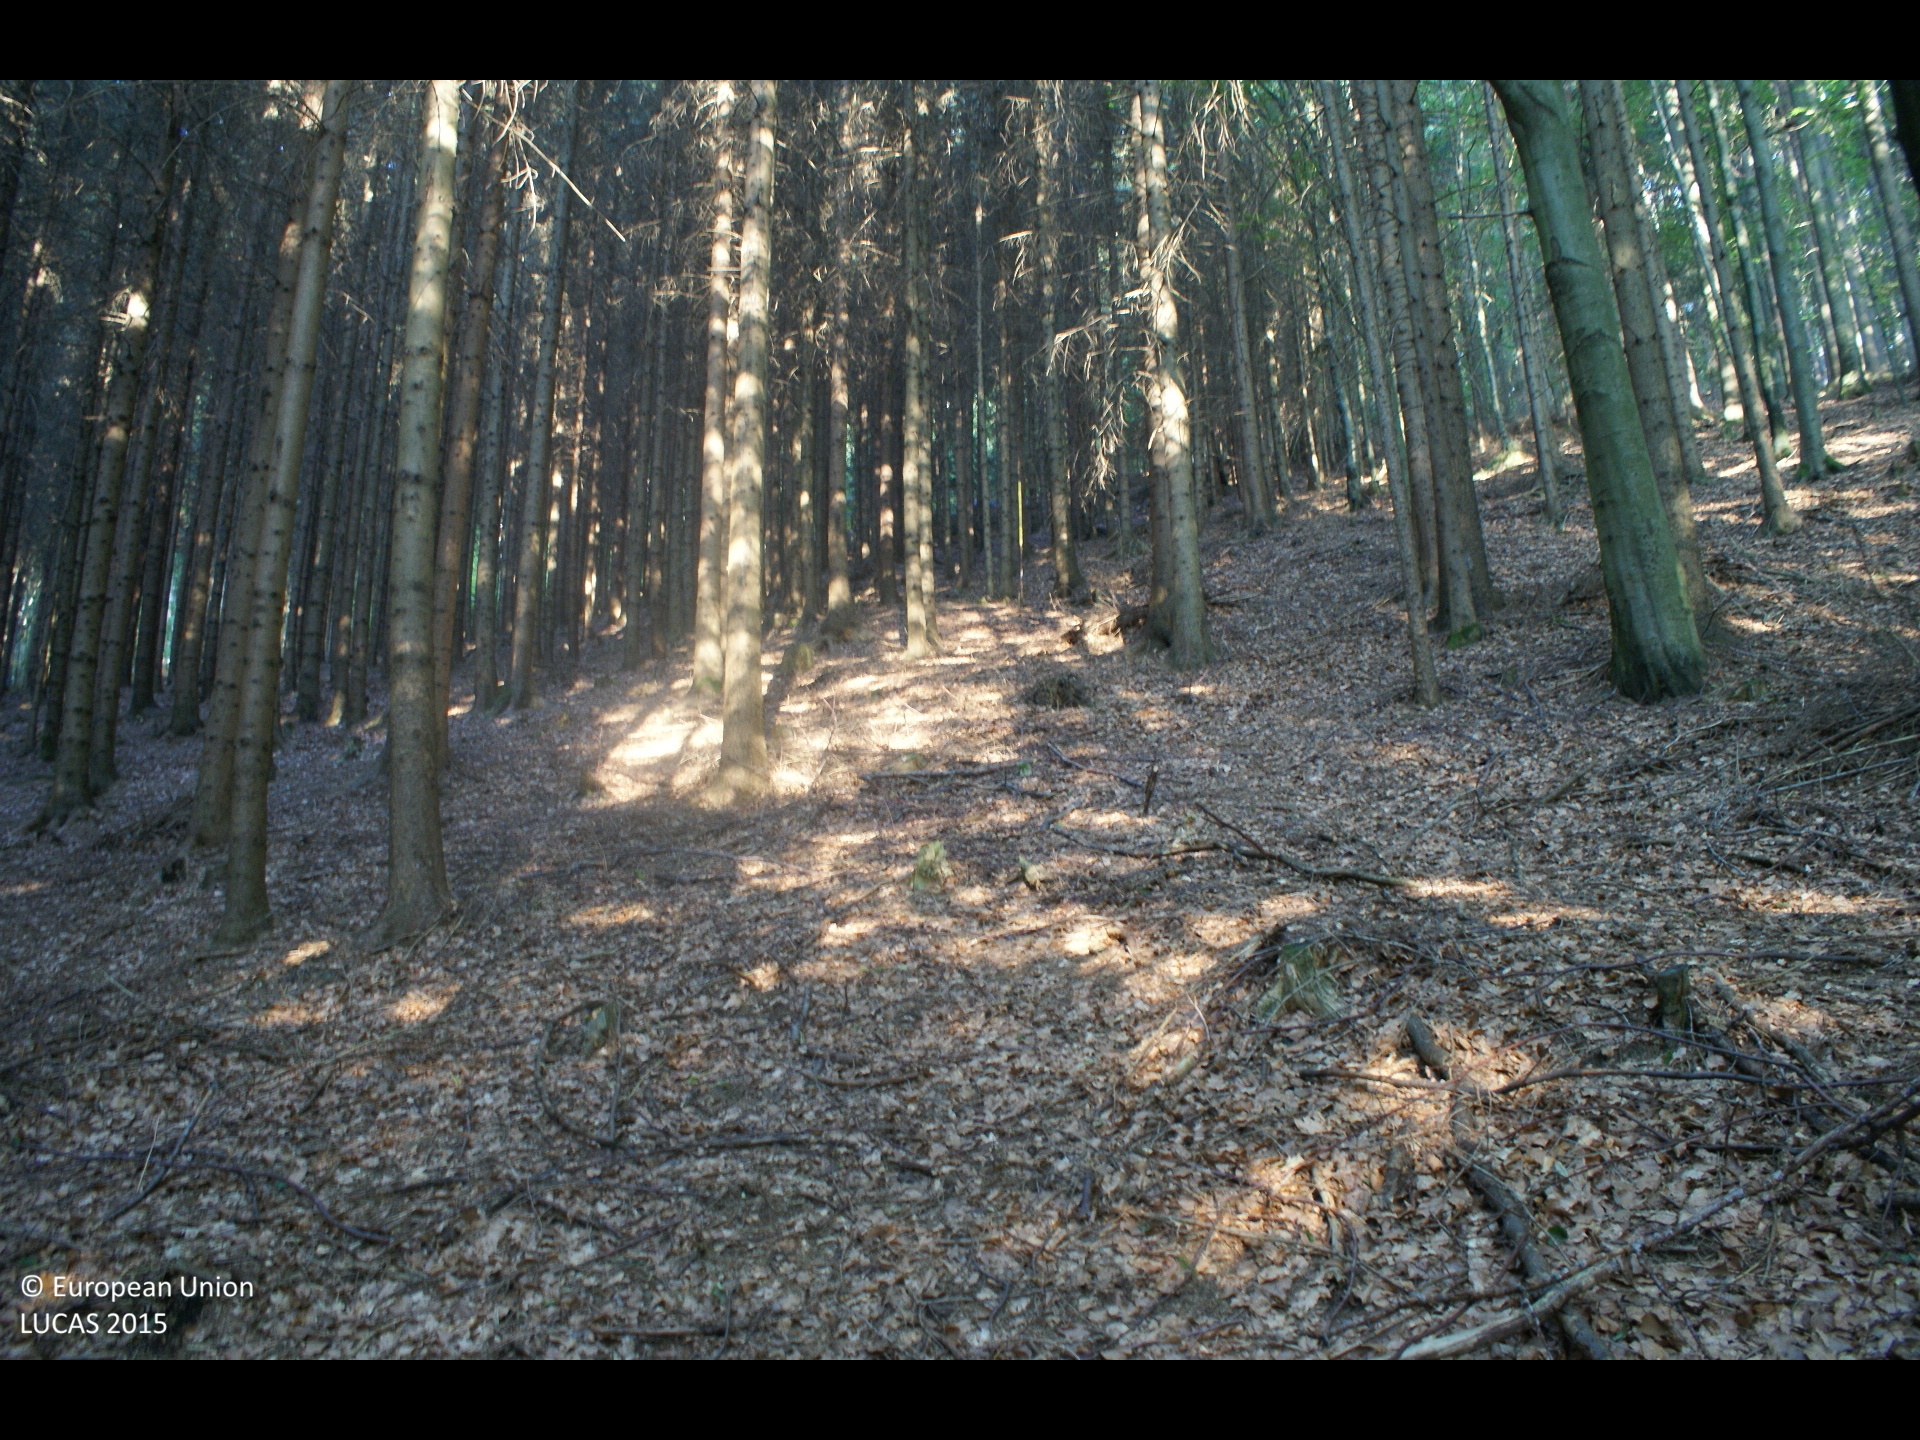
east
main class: Woodland
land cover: Spruce dominated coniferous woodland
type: alpine coniferous forest
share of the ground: > 75 %
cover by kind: coniferous forest trees 100 %
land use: Forestry
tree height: > 5 m
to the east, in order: Spruce dominated coniferous woodland; Other mixed woodland; Tracks; Spruce dominated mixed woodland; Other mixed woodland; Tracks; Other mixed woodland; Spruce dominated mixed woodland; Tracks; Spruce dominated mixed woodland
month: July
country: AT
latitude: 47.9253
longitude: 13.7598
